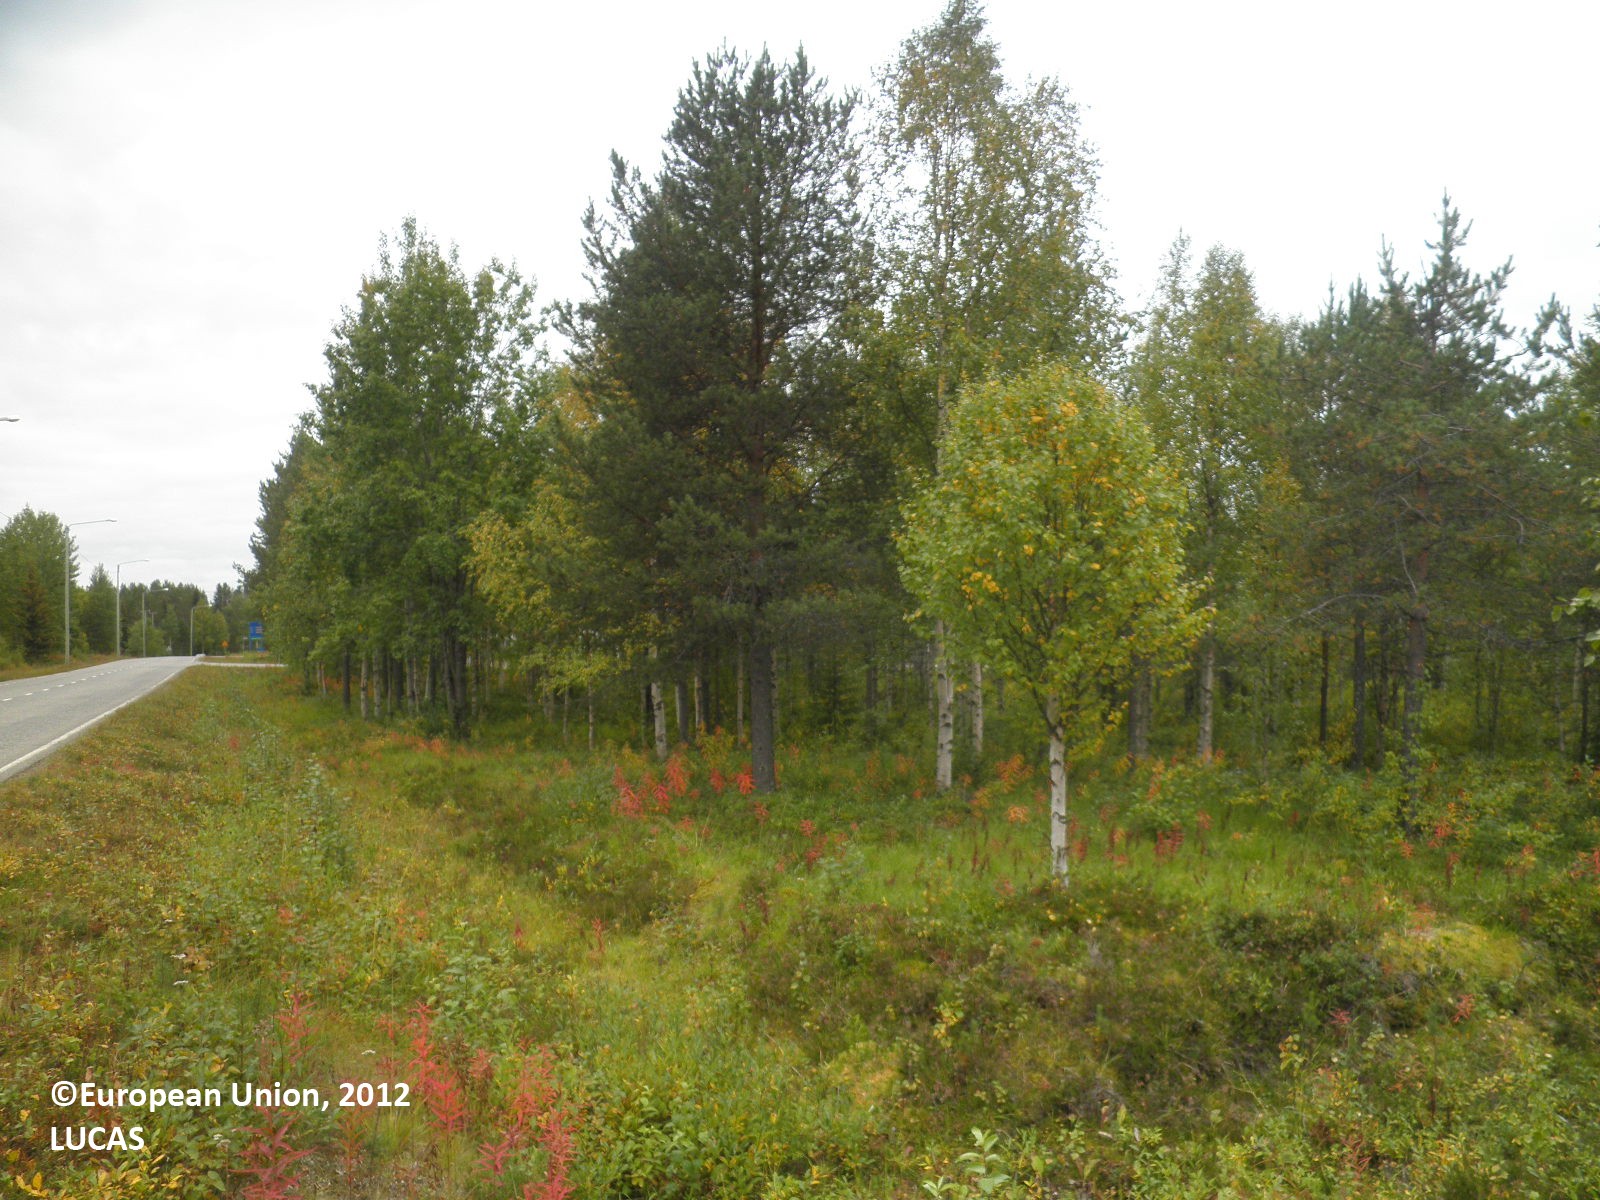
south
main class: Shrubland
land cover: Shrubland with sparse tree cover
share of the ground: > 75 %
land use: Road transport
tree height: < 5 m
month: August
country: FI
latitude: 67.2982
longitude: 28.1626
